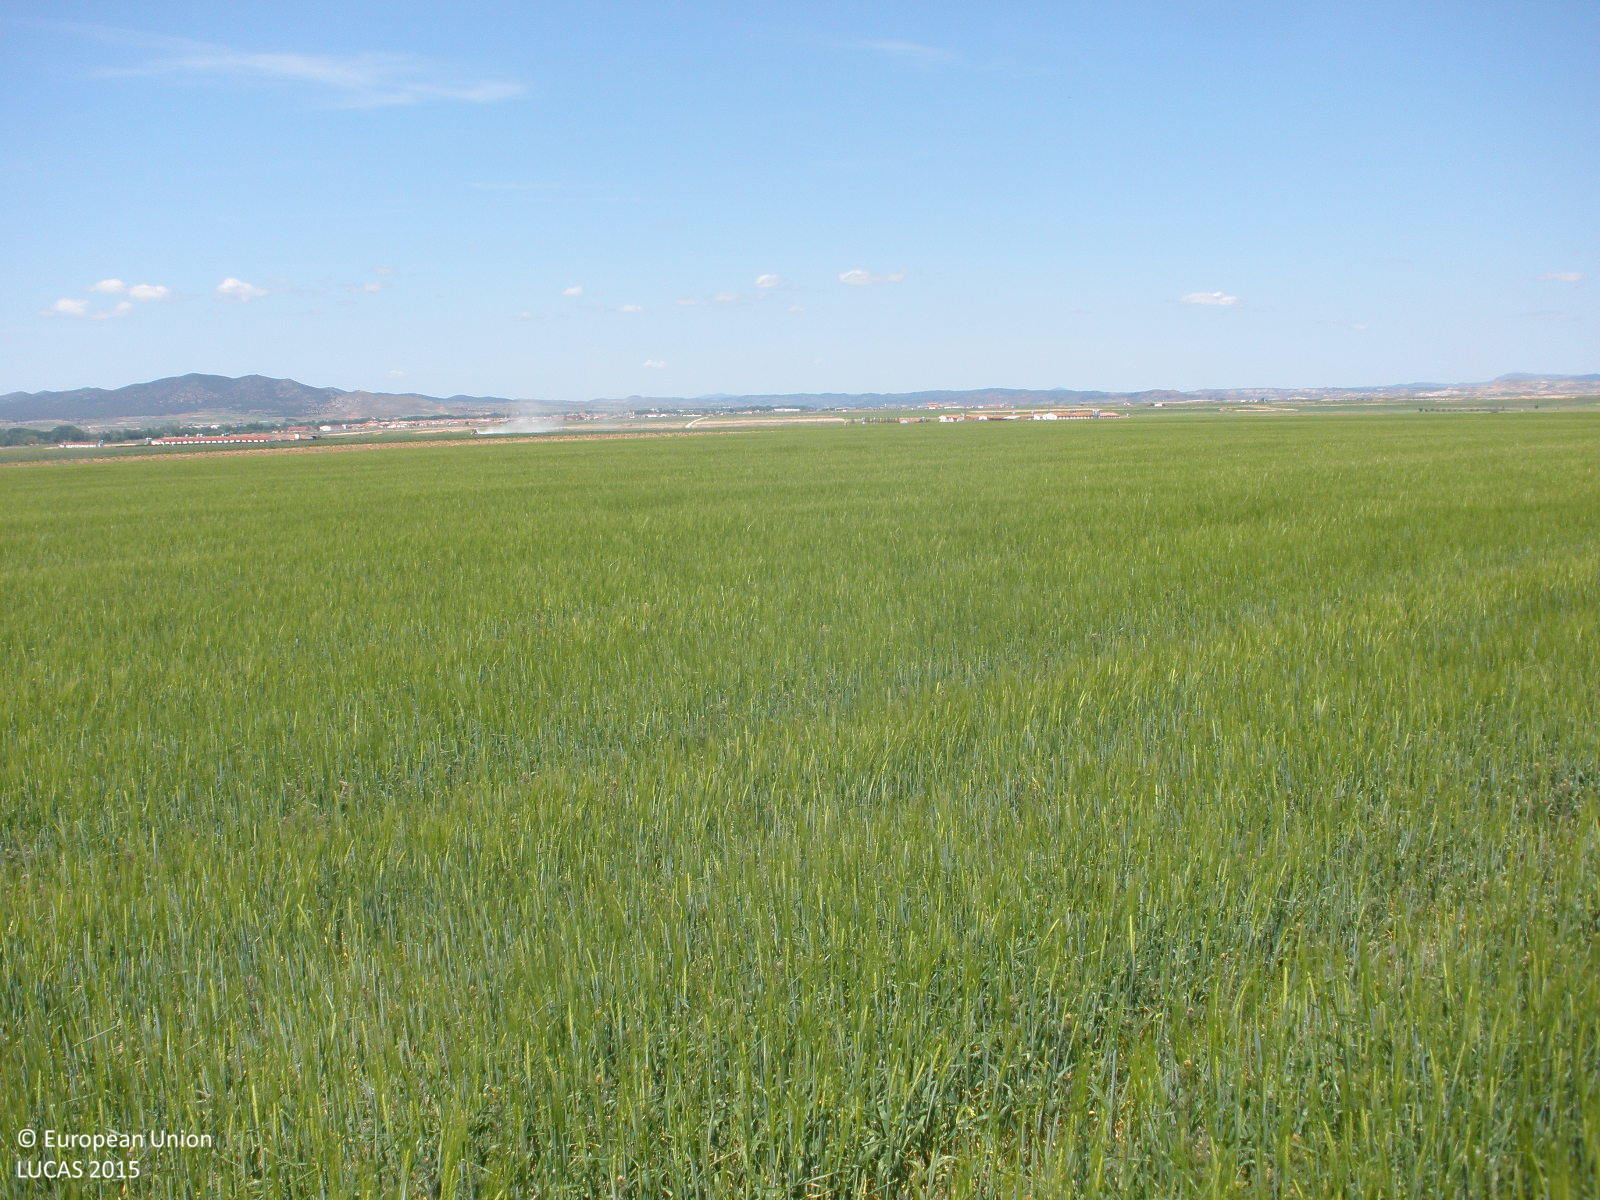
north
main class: Cropland
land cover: Barley
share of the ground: > 75 %
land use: Agriculture (excluding fallow land and kitchen gardens)
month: May
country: ES
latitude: 40.7969
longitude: -1.3120
